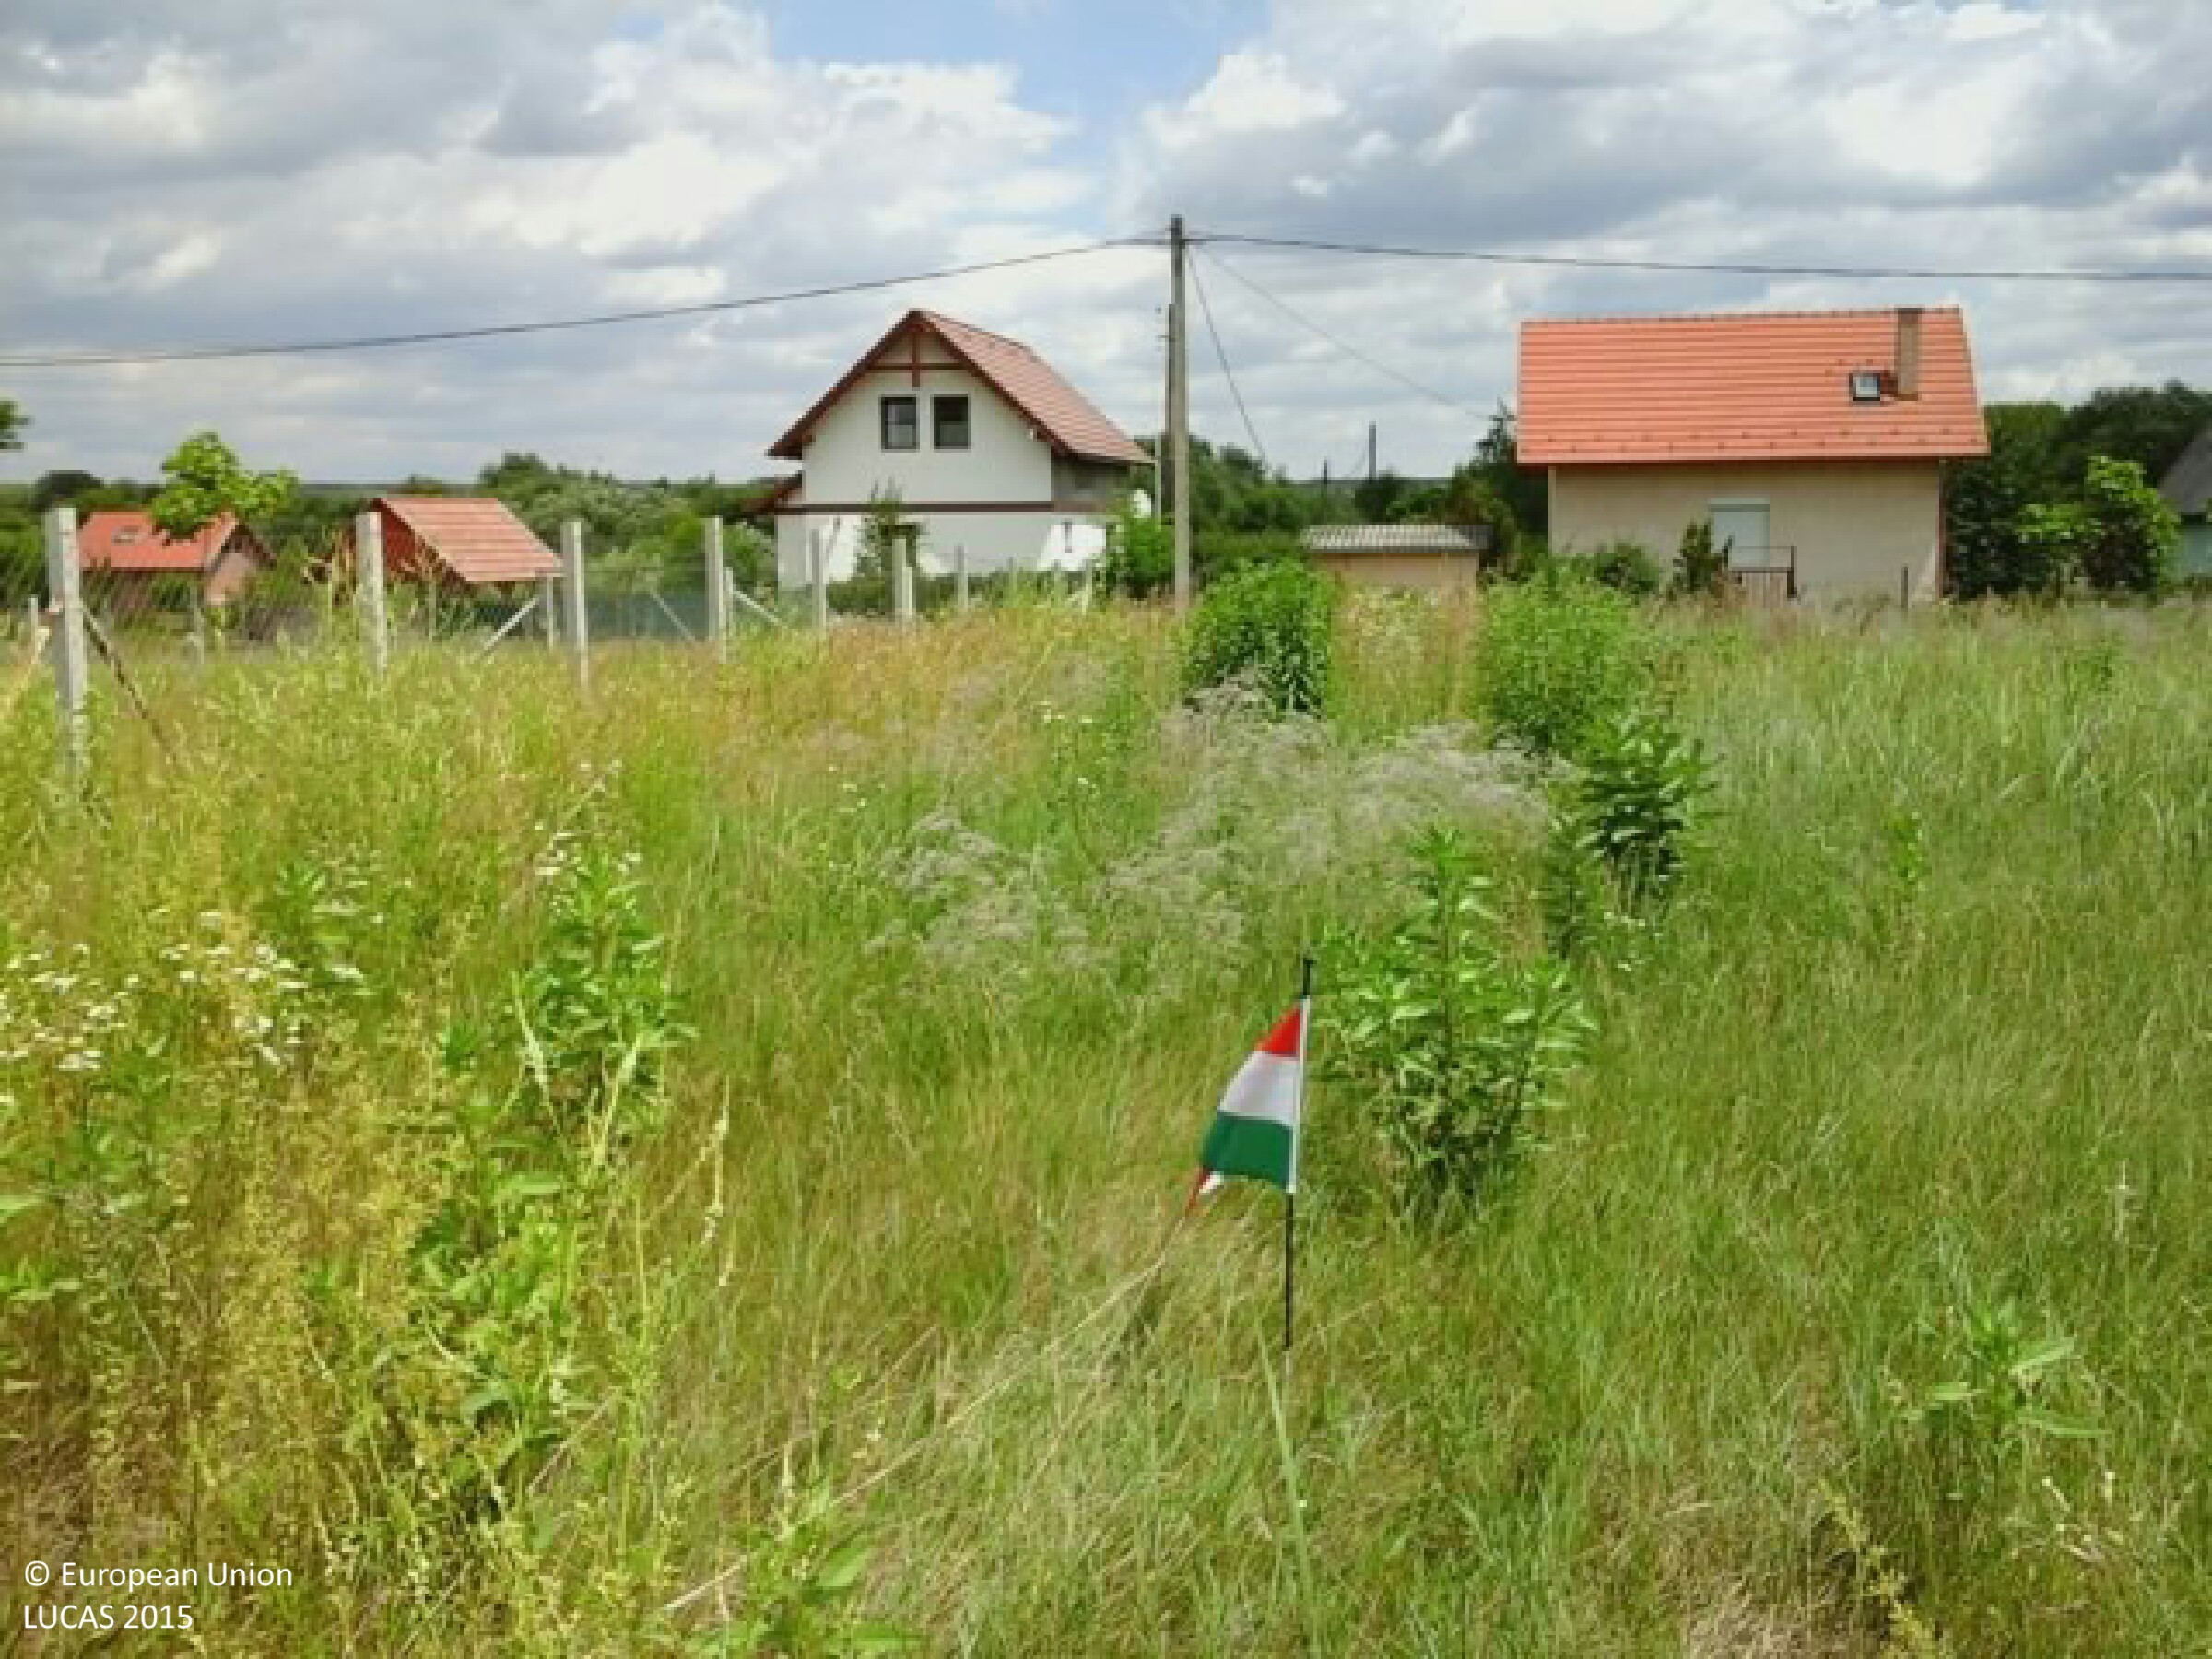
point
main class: Grassland
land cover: Spontaneously vegetated surfaces
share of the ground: > 75 %
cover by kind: herbaceous plants 100 %
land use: Fallow land
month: June
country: HU
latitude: 47.5325
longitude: 19.3854
